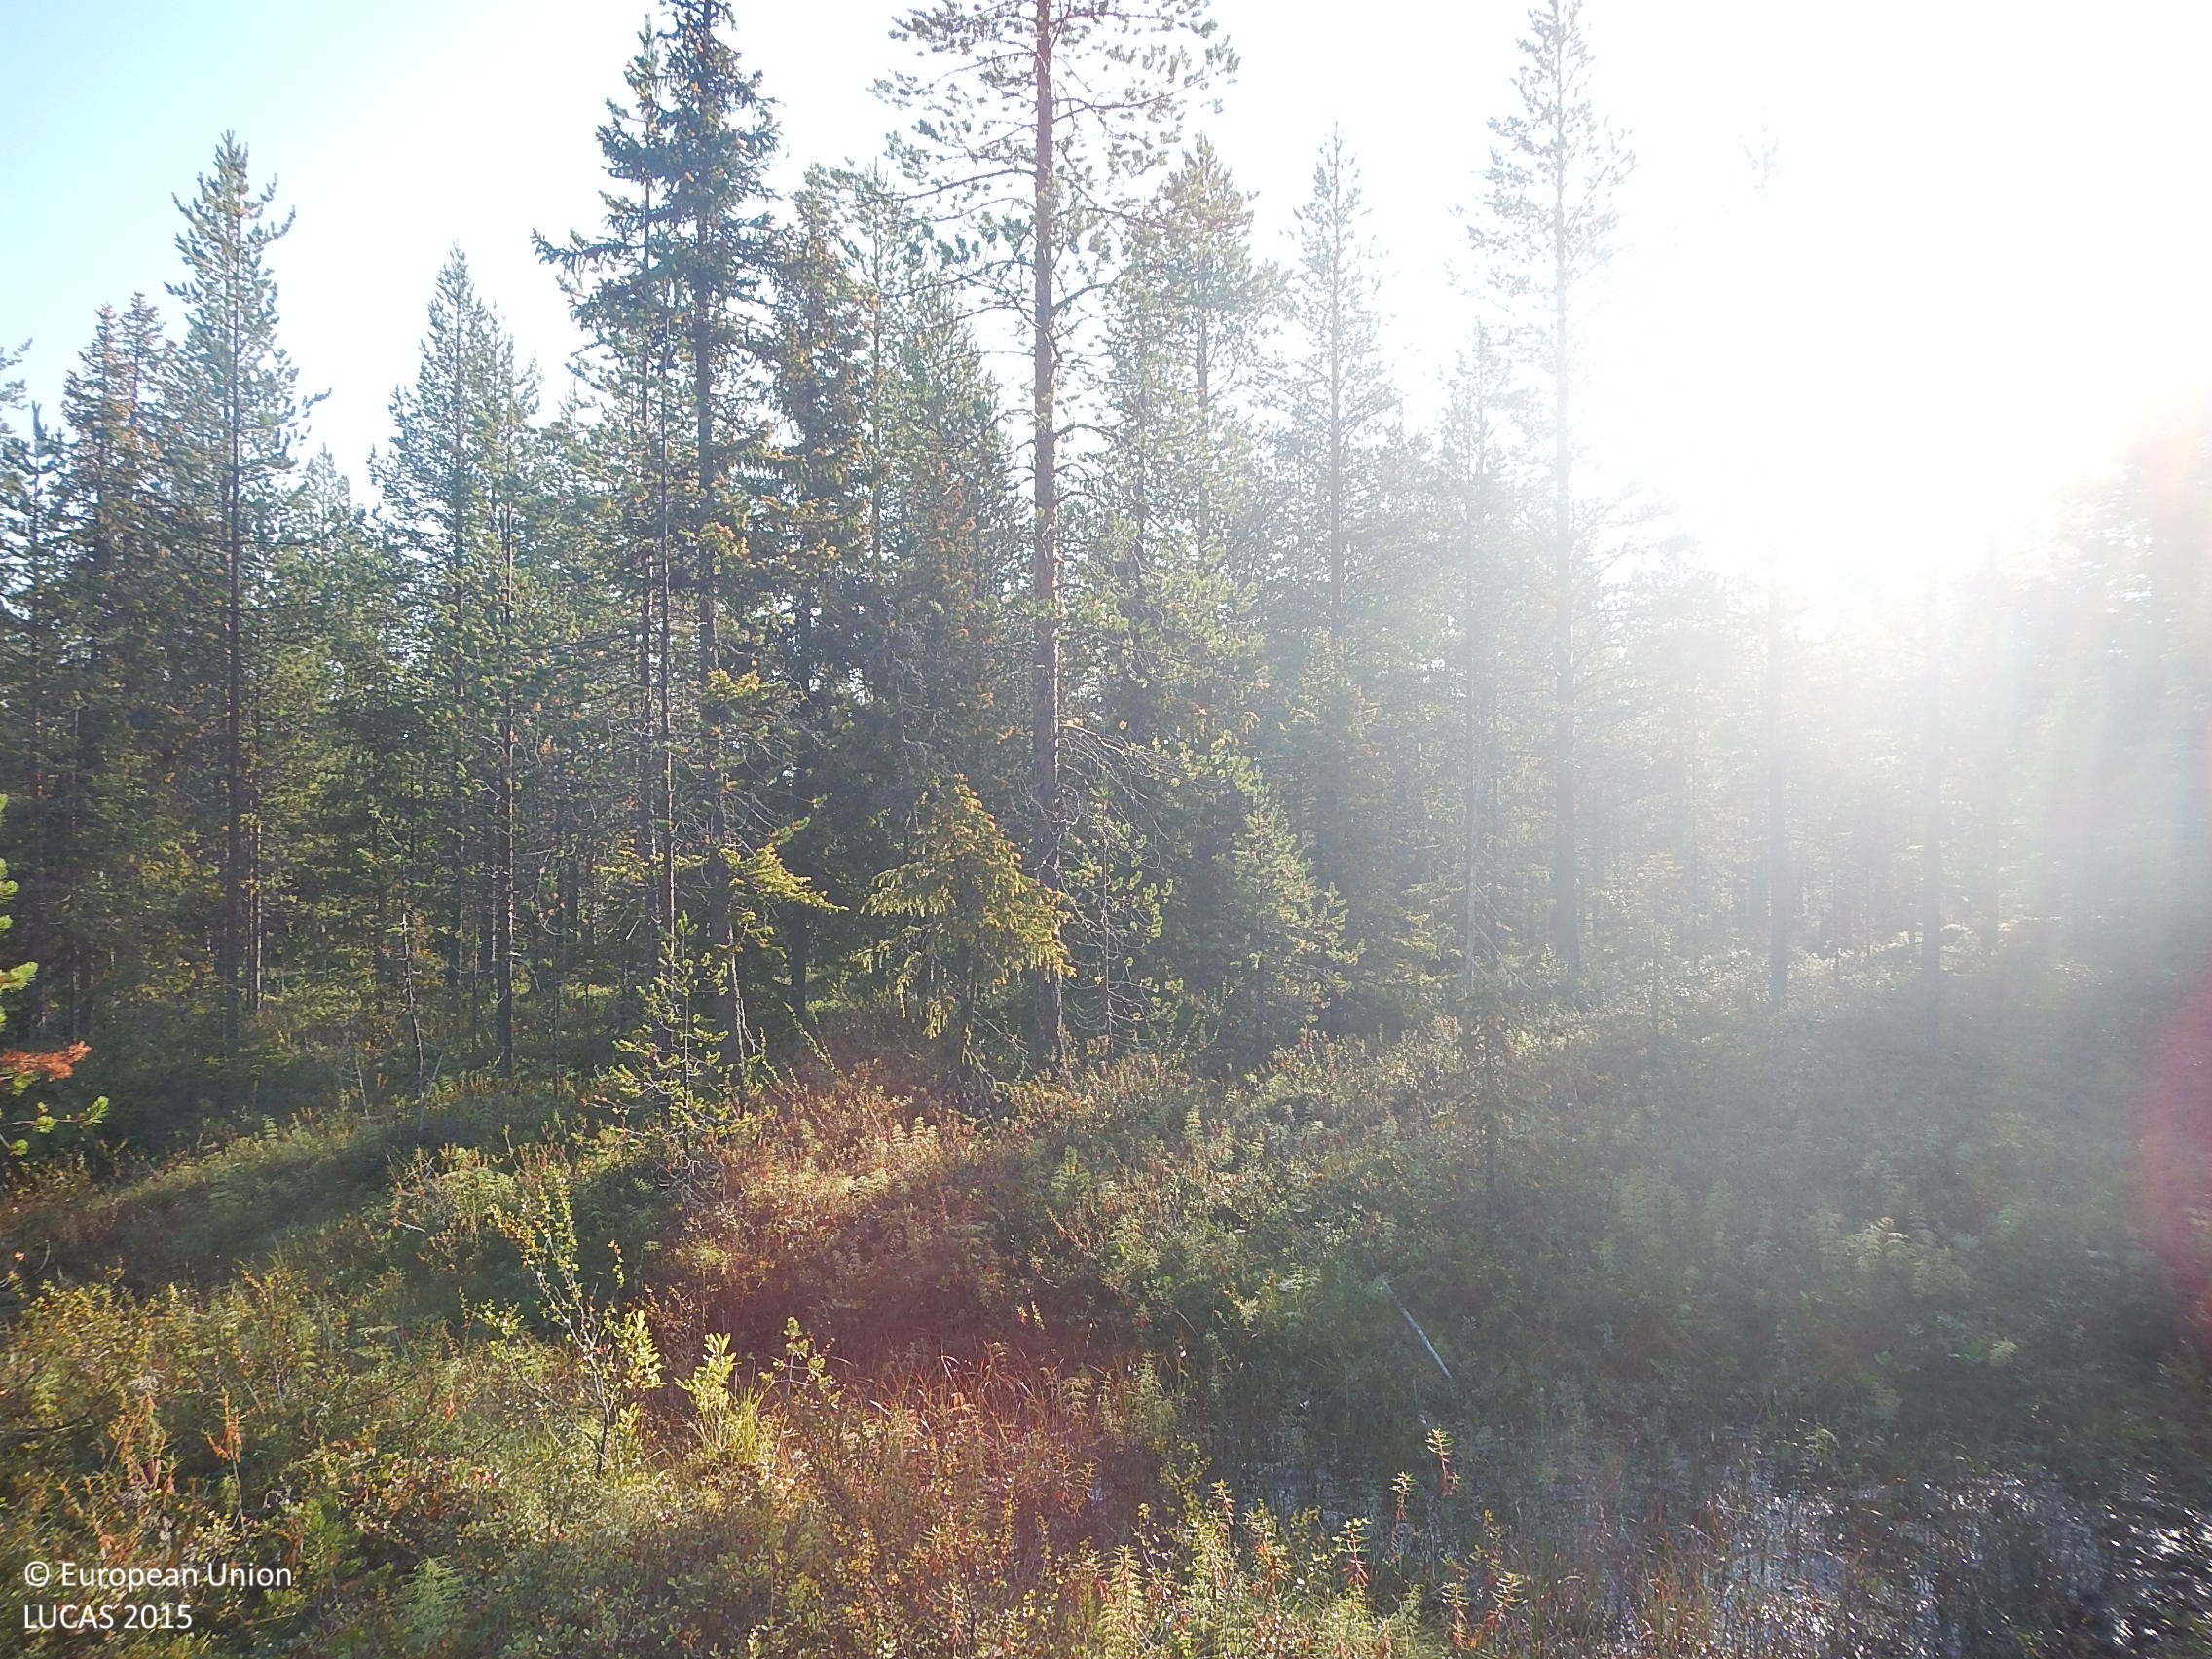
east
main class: Woodland
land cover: Pine dominated coniferous woodland
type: boreal forest
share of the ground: 10 - 25 %
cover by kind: shrubs 70 %, coniferous forest trees 15 %, lichens and mosses 10 %, herbaceous plants 5 %
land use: Forestry
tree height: < 5 m
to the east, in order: Pine dominated coniferous woodland; Ponds and wetlands; Pine dominated coniferous woodland; Other coniferous woodland; Pine dominated coniferous woodland; Other mixed woodland
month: August
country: FI
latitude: 66.4643
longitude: 28.2486
